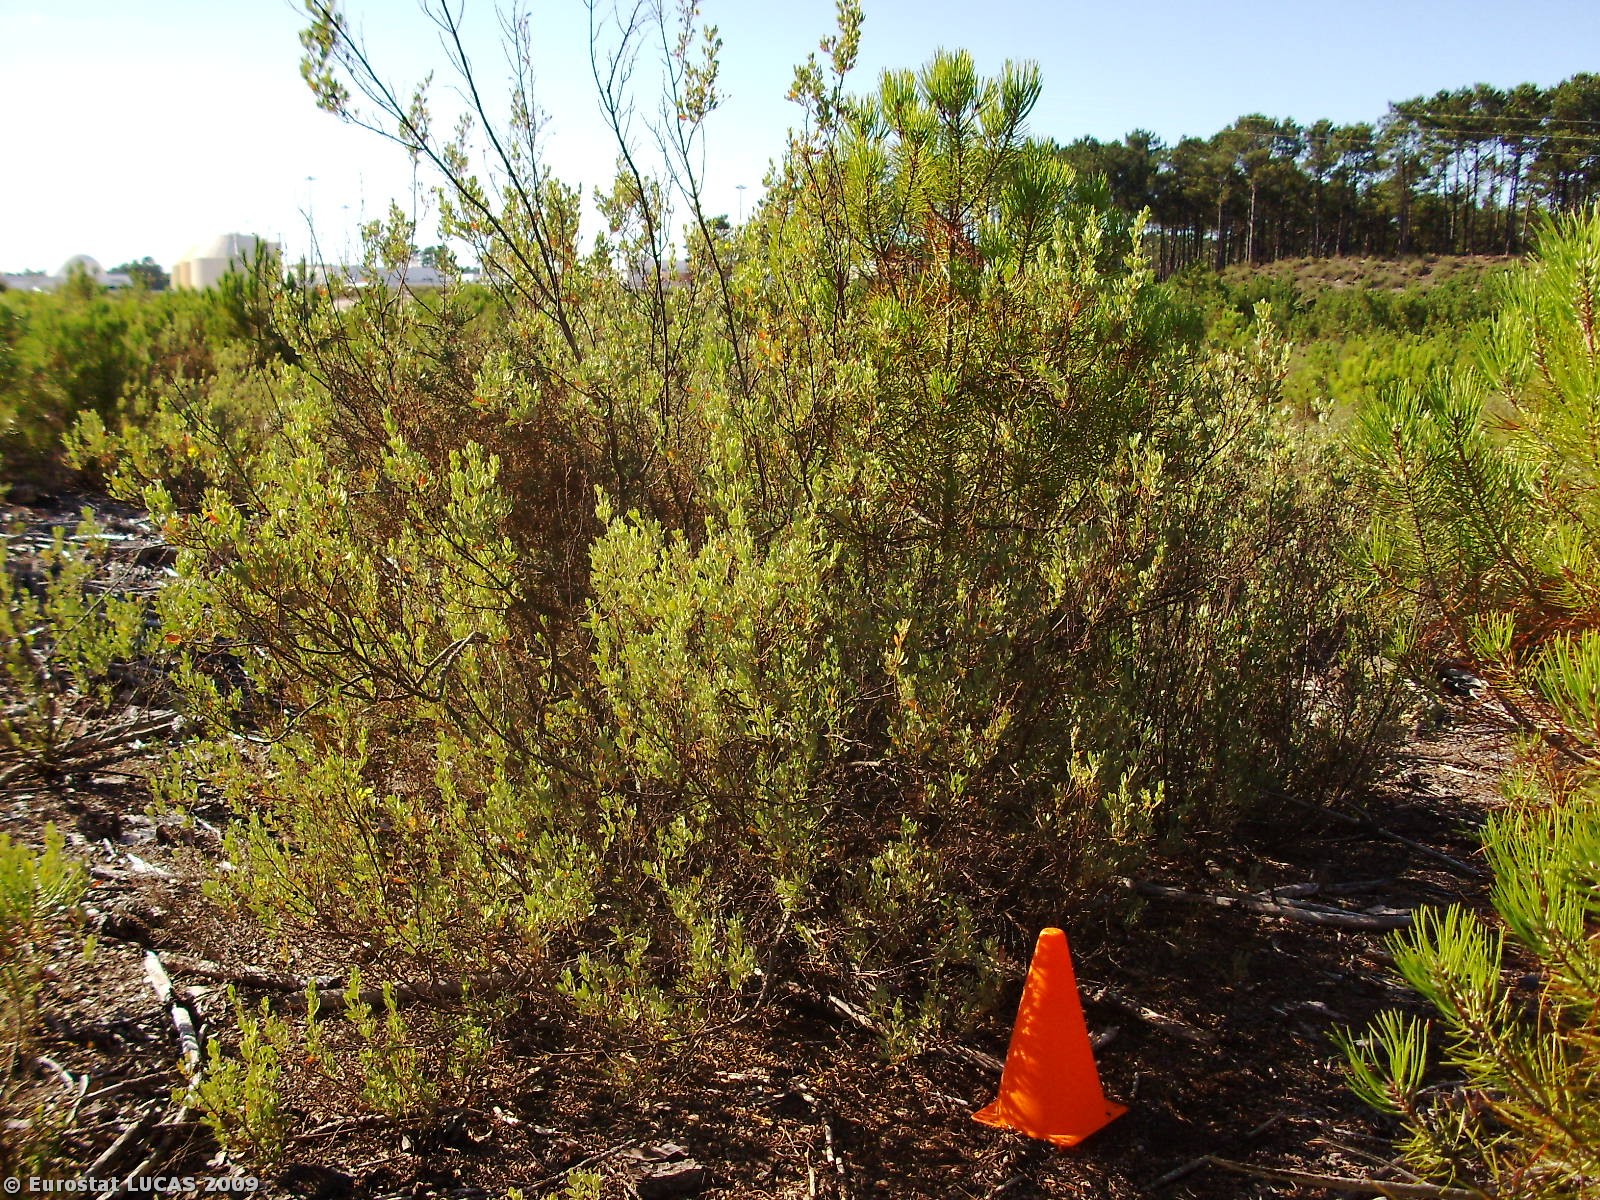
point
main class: Woodland
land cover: Coniferous woodland
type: coniferous forest of the mediterranean region
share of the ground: 25 - 50 %
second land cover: Shrubland with sparse tree cover
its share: 50 - 75 %
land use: Forestry
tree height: > 5 m
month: August
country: PT
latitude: 39.8912
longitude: -8.9084
